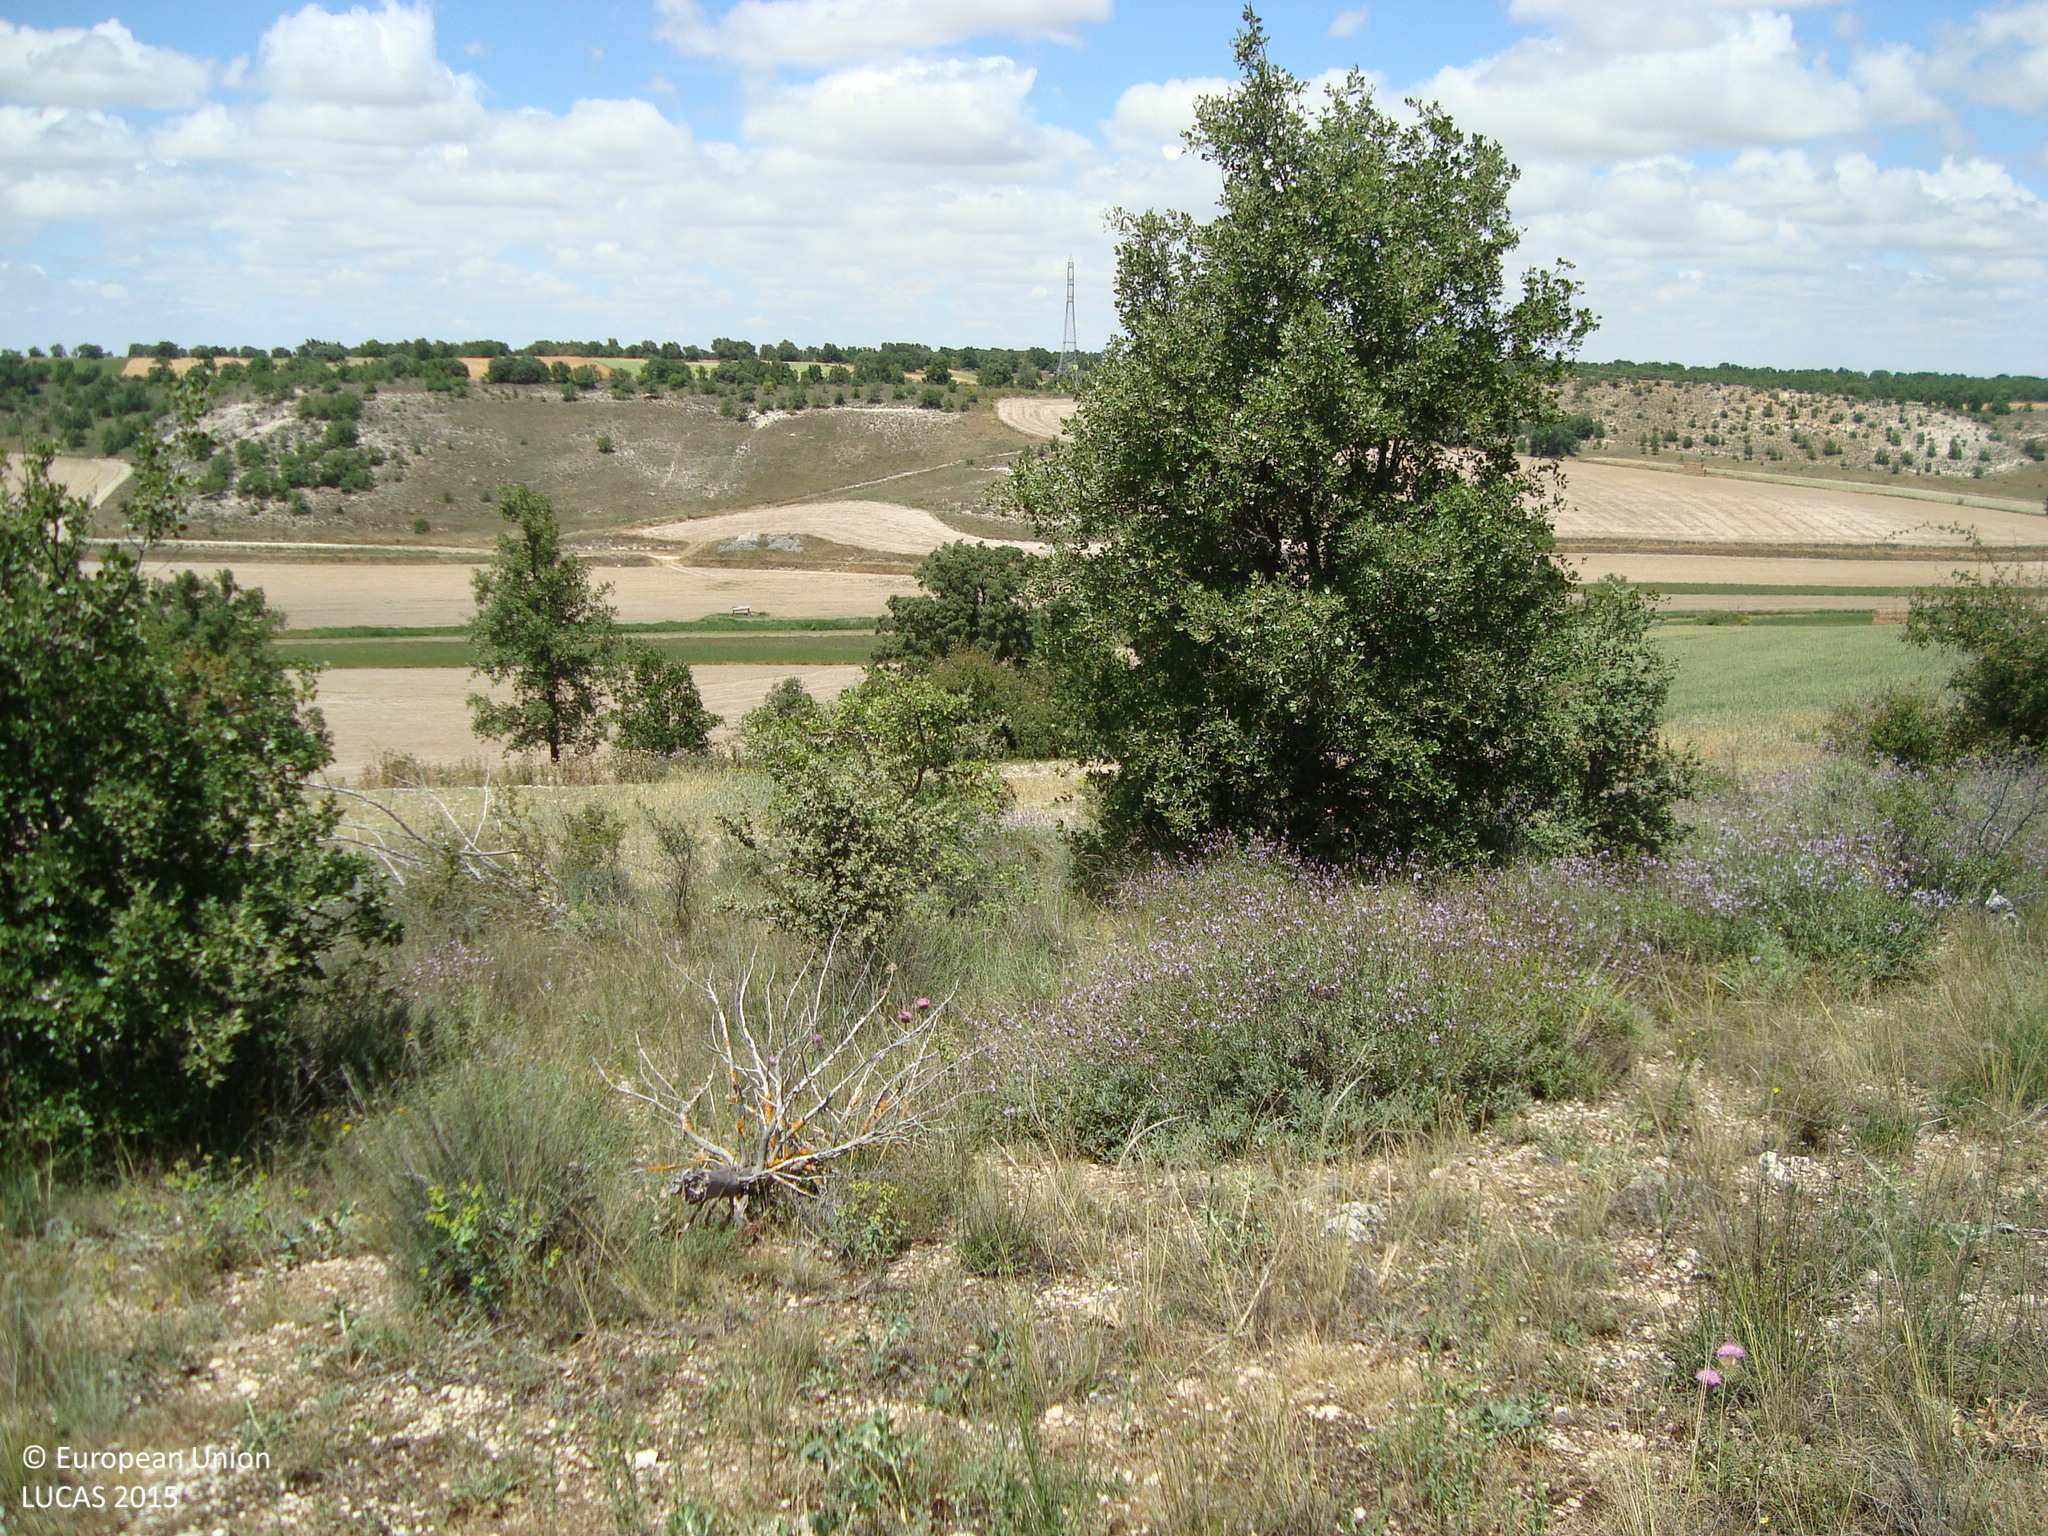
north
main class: Grassland
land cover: Grassland with sparse tree/shrub cover
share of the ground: > 75 %
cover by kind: herbaceous plants 65 %, unconsolidated bare surface 25 %, broadleaved forest trees 5 %, shrubs 5 %
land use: Forestry
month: June
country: ES
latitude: 41.6986
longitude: -4.2285
